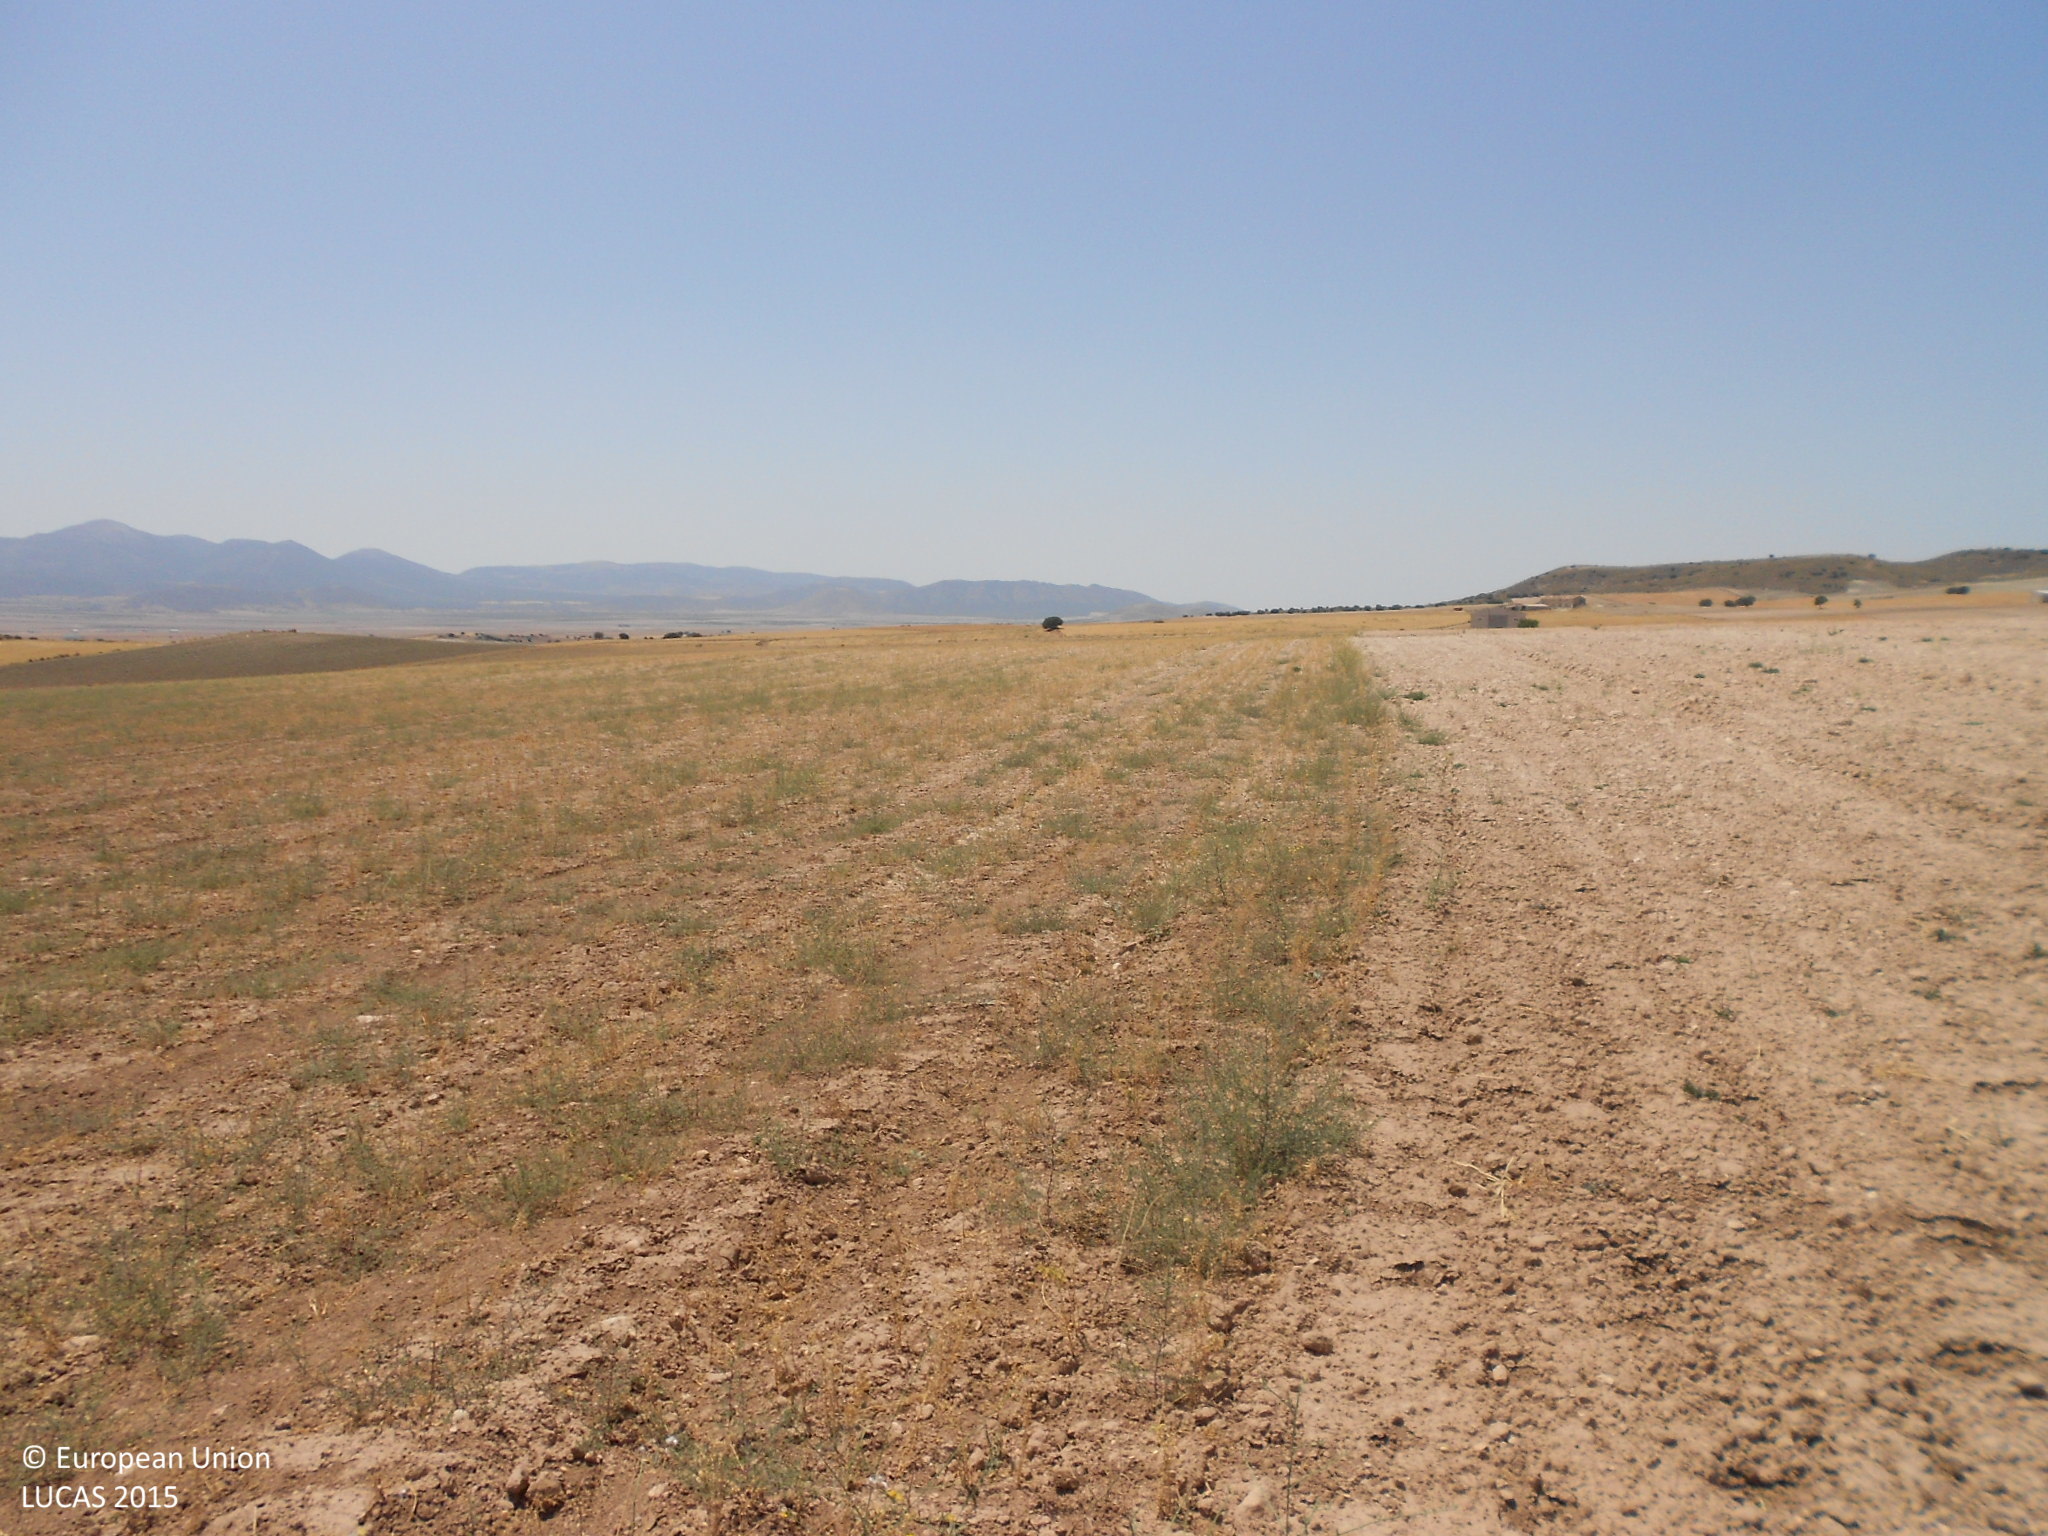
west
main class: Grassland
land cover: Spontaneously vegetated surfaces
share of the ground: 25 - 50 %
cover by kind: consolidated bare surface 60 %, herbaceous plants 40 %
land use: Fallow land
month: August
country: ES
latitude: 37.7366
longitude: -2.2763
